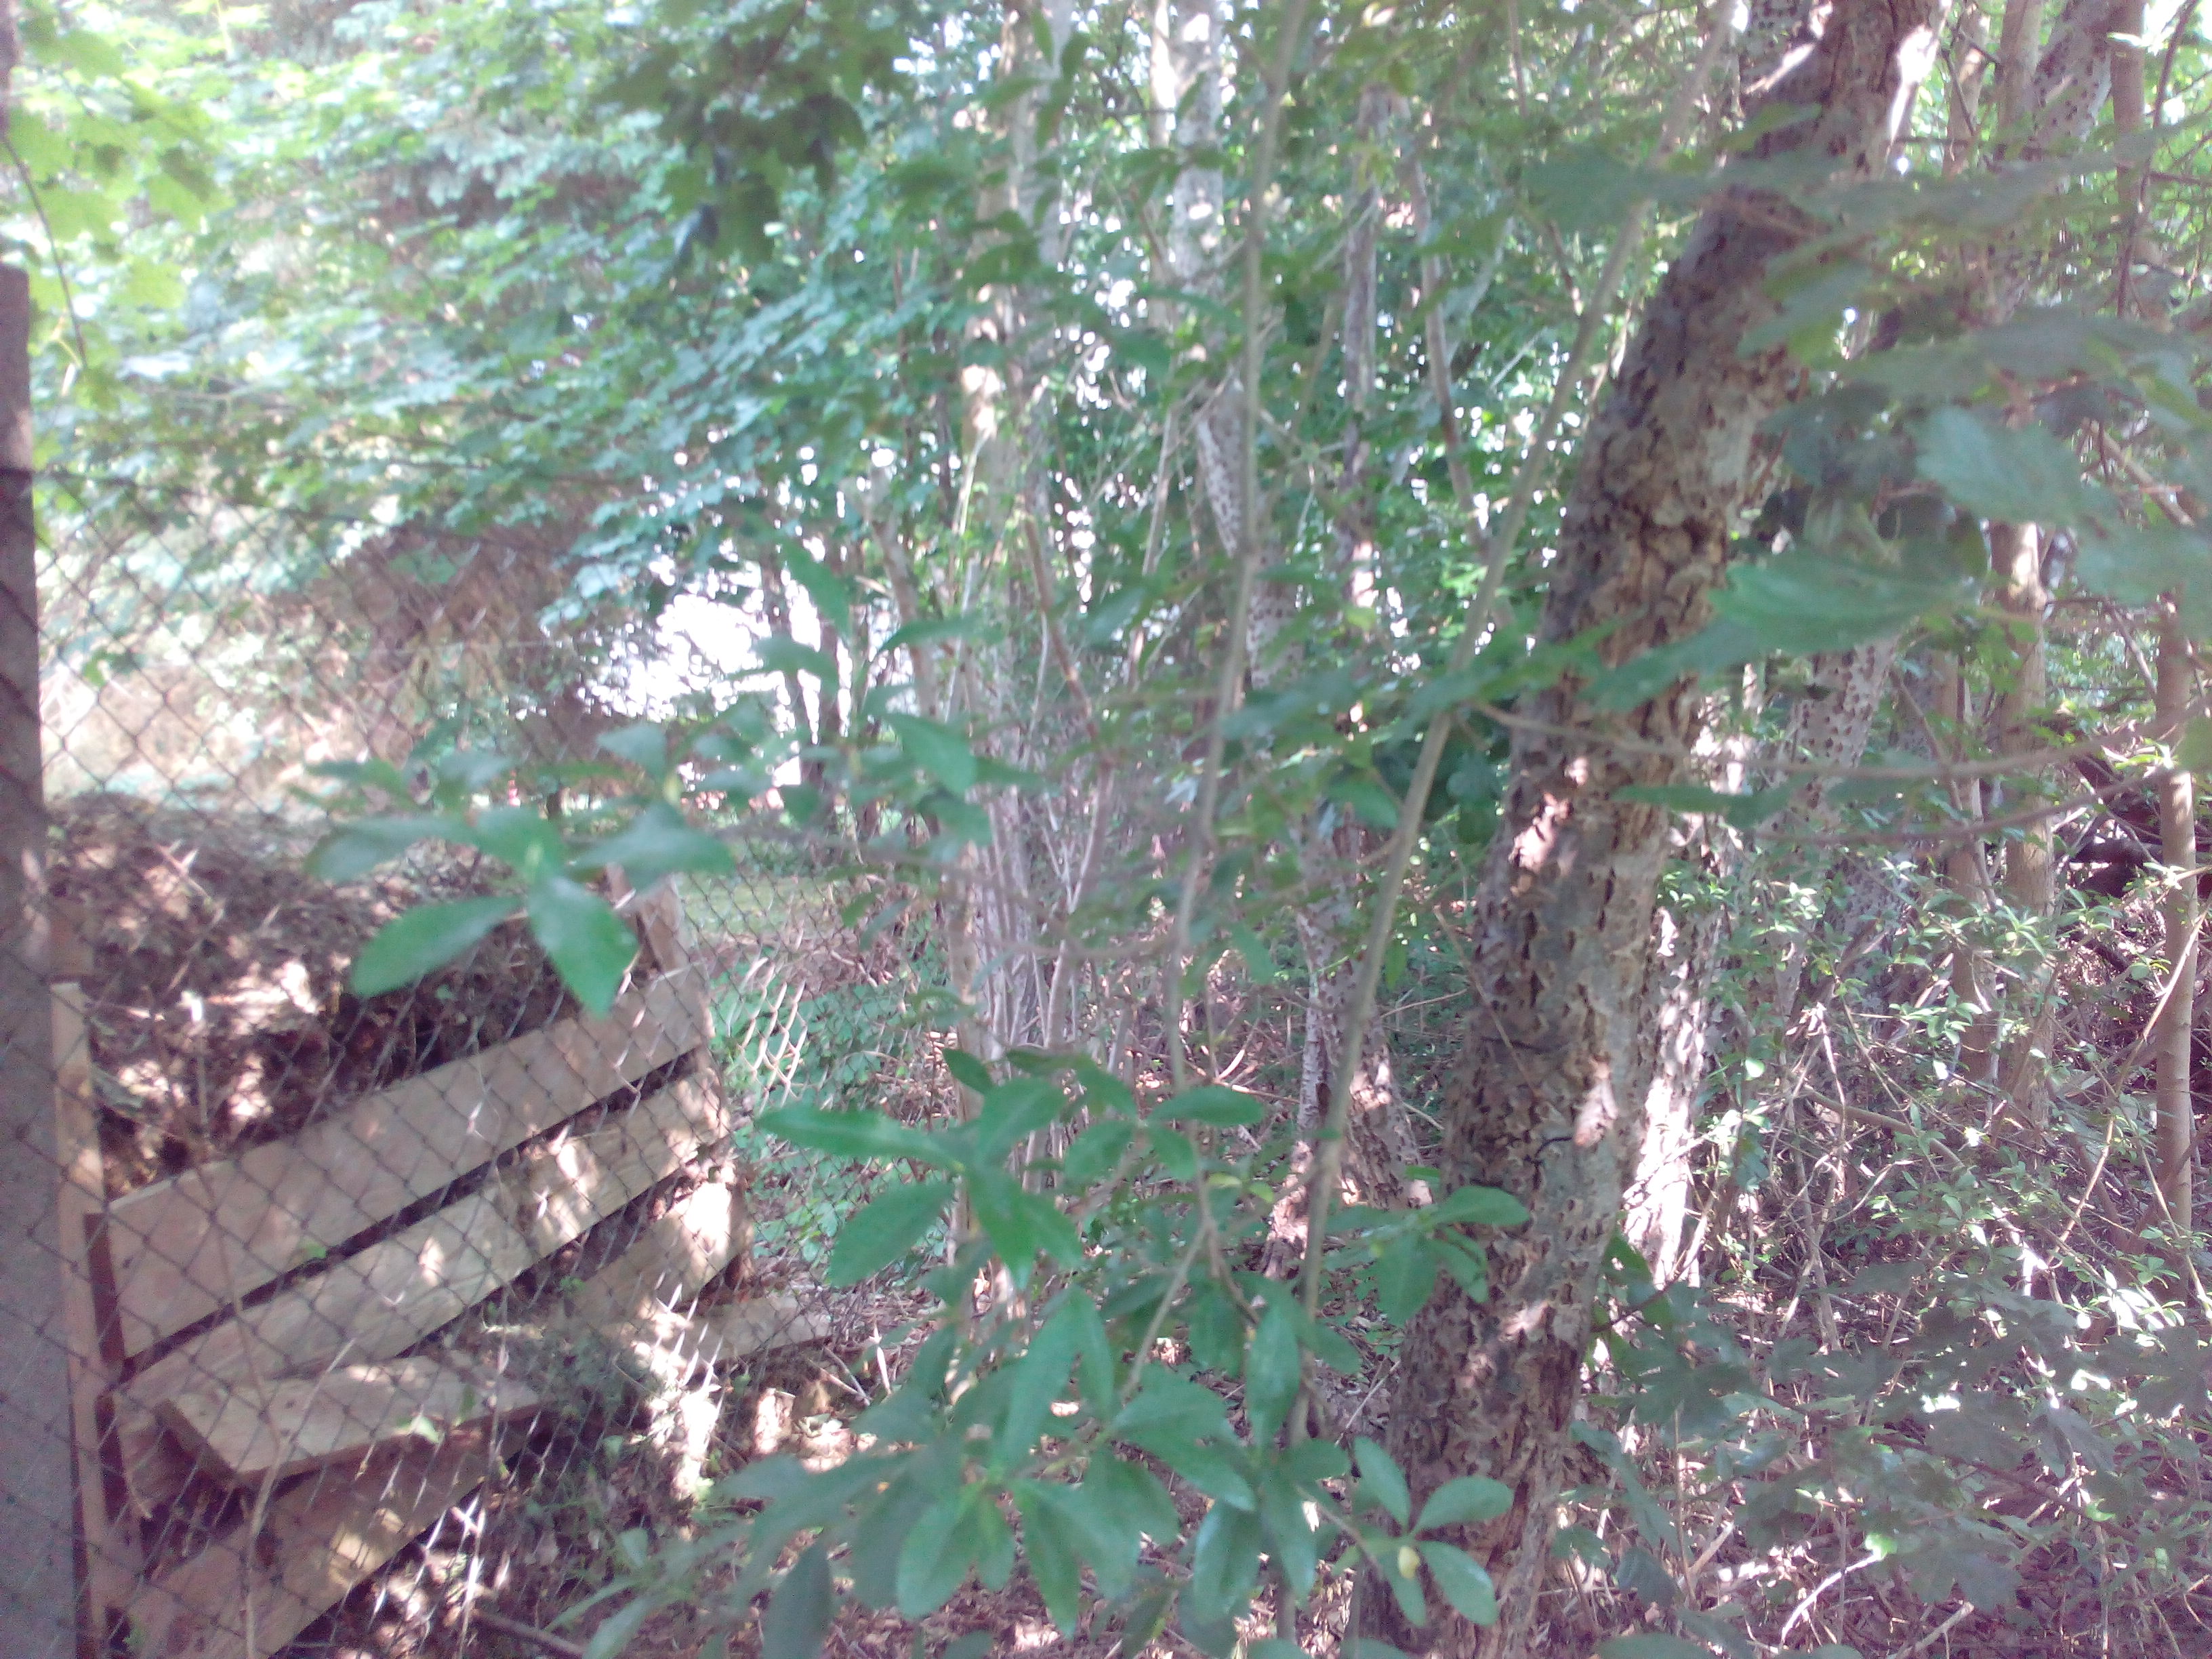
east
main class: Woodland
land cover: Broadleaved woodland
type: mesophytic deciduous forest
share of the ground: > 75 %
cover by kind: broadleaved forest trees 90 %, herbaceous plants 10 %
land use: Semi-natural and natural areas not in use
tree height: > 5 m
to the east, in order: Broadleaved woodland; Artificial constructions in urban areas
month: June
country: DE
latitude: 50.9021
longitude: 10.5544
